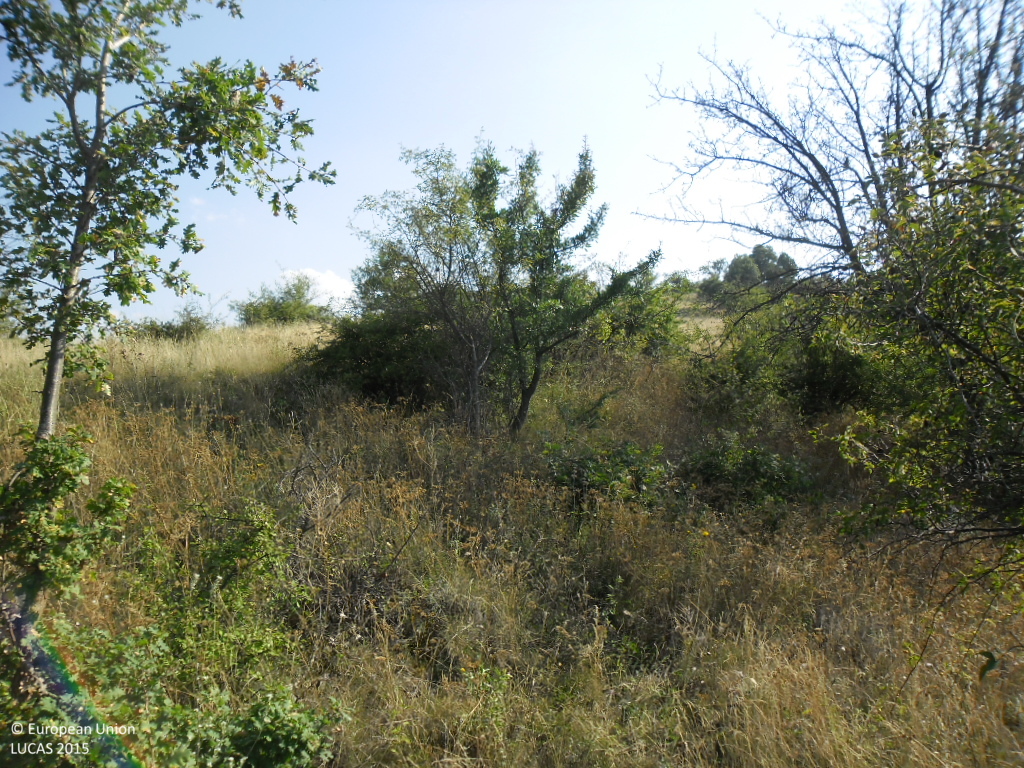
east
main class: Woodland
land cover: Broadleaved woodland
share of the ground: 50 - 75 %
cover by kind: broadleaved forest trees 70 %, herbaceous plants 20 %, shrubs 10 %
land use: Forestry
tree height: < 5 m
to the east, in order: Broadleaved woodland; Tracks; Grassland with sparse tree/shrub cover; Fences; Grassland with sparse tree/shrub cover; Fences; Other fruit trees and berries; Fences; Grassland with sparse tree/shrub cover; Broadleaved woodland; Grassland with sparse tree/shrub cover; Tracks; Grassland with sparse tree/shrub cover; Broadleaved woodland
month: August
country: BG
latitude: 41.9626
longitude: 22.9685
